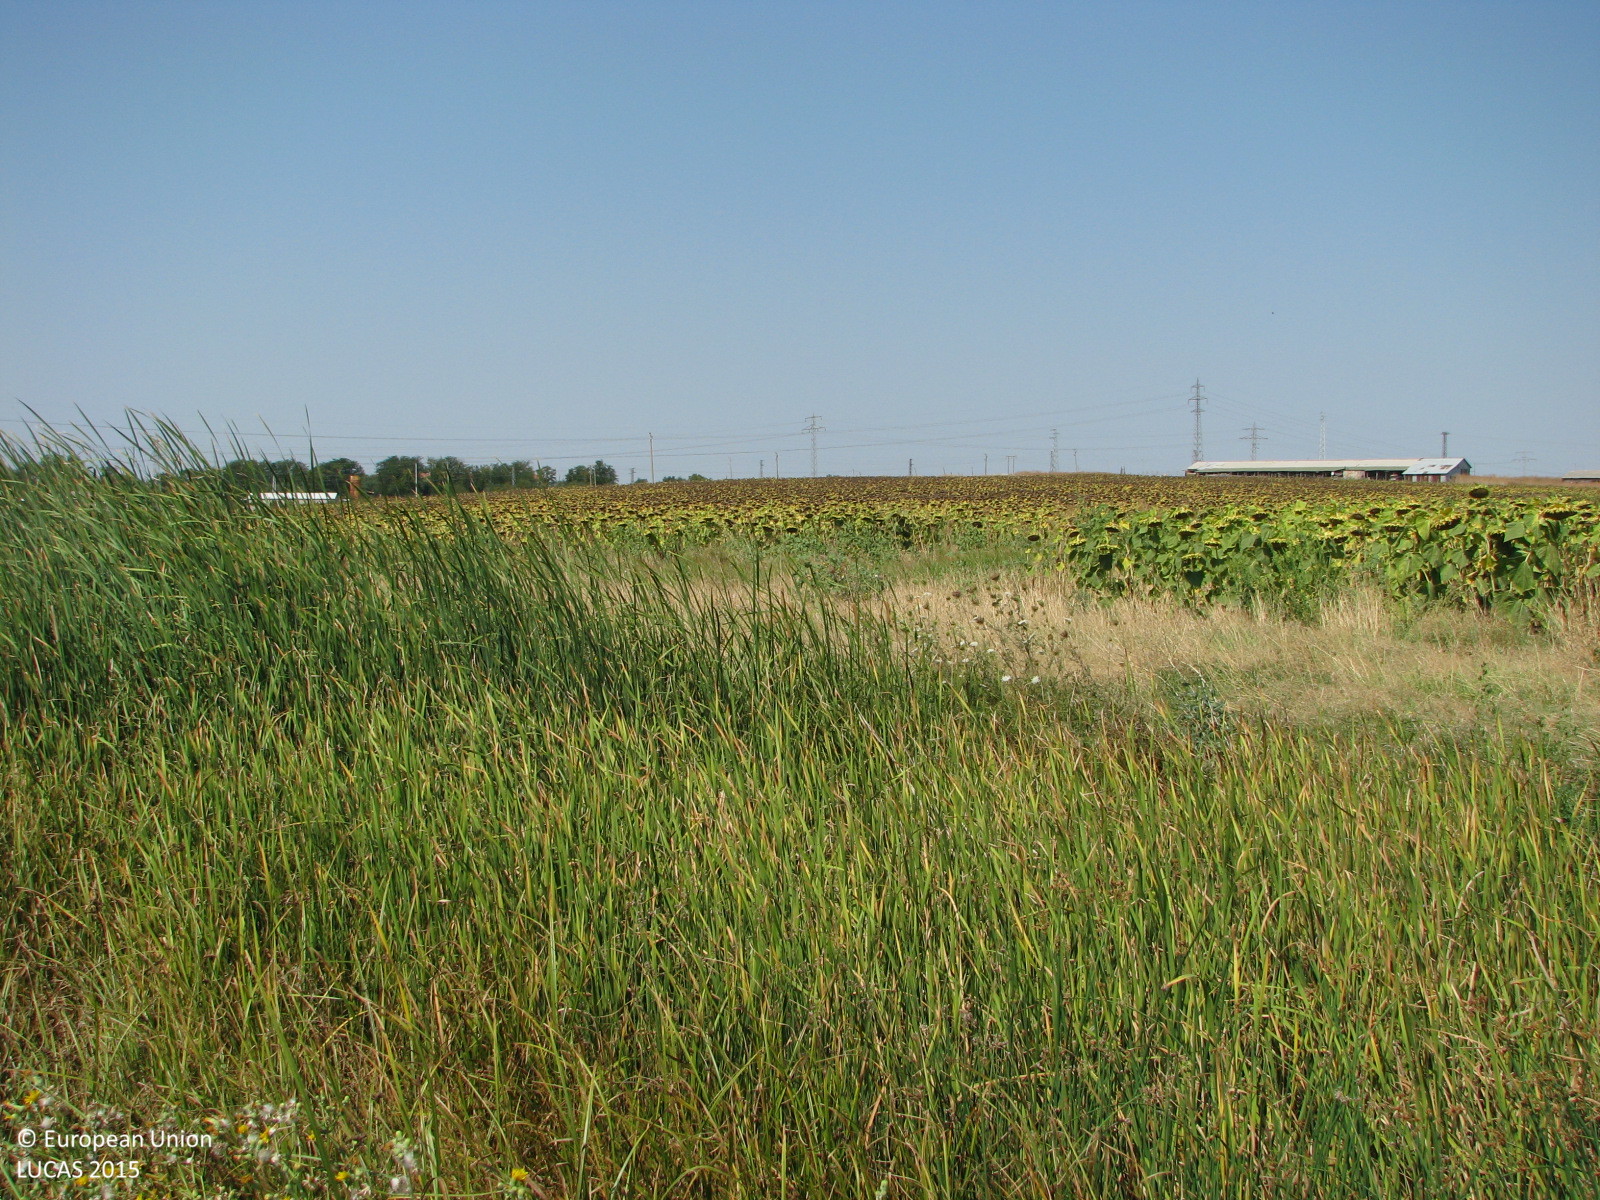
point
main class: Cropland
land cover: Sunflower
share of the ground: > 75 %
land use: Agriculture (excluding fallow land and kitchen gardens)
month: August
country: BG
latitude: 42.1760
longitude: 26.5910
